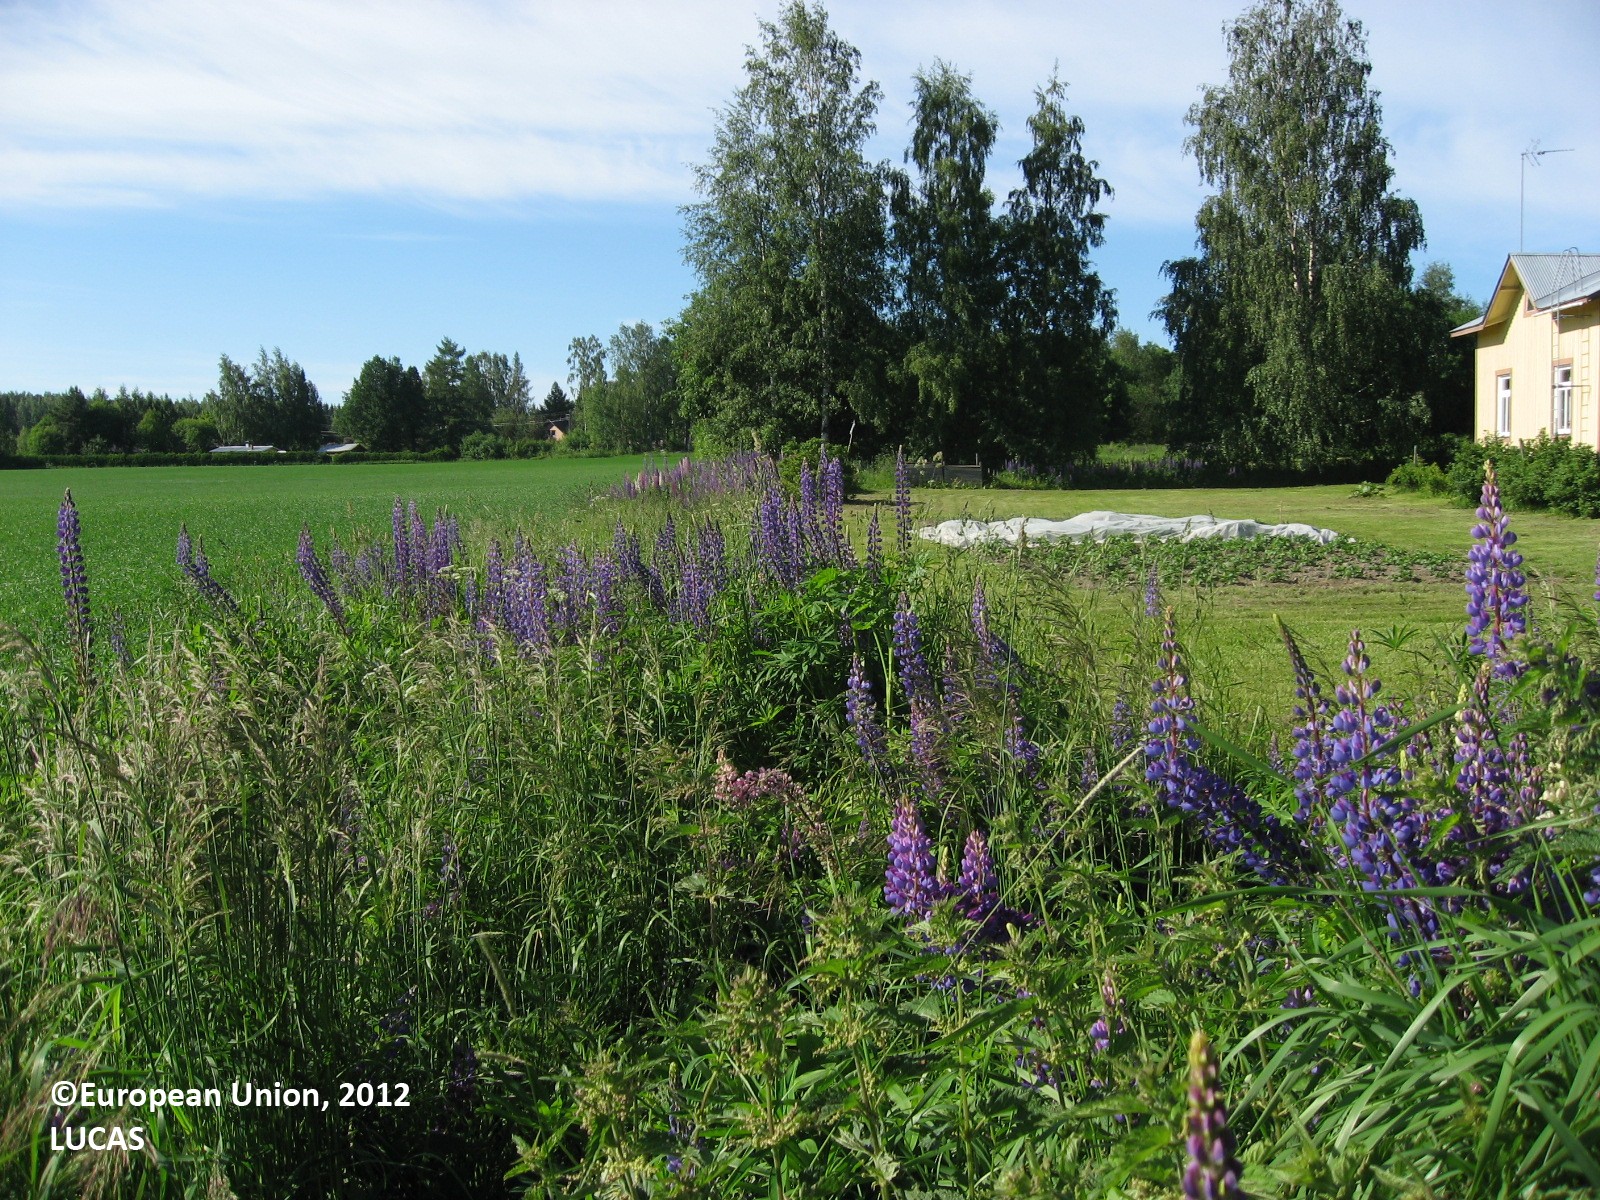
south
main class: Grassland
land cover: Spontaneously vegetated surfaces
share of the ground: > 75 %
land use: Semi-natural and natural areas not in use
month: June
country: FI
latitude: 60.4301
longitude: 26.2262
